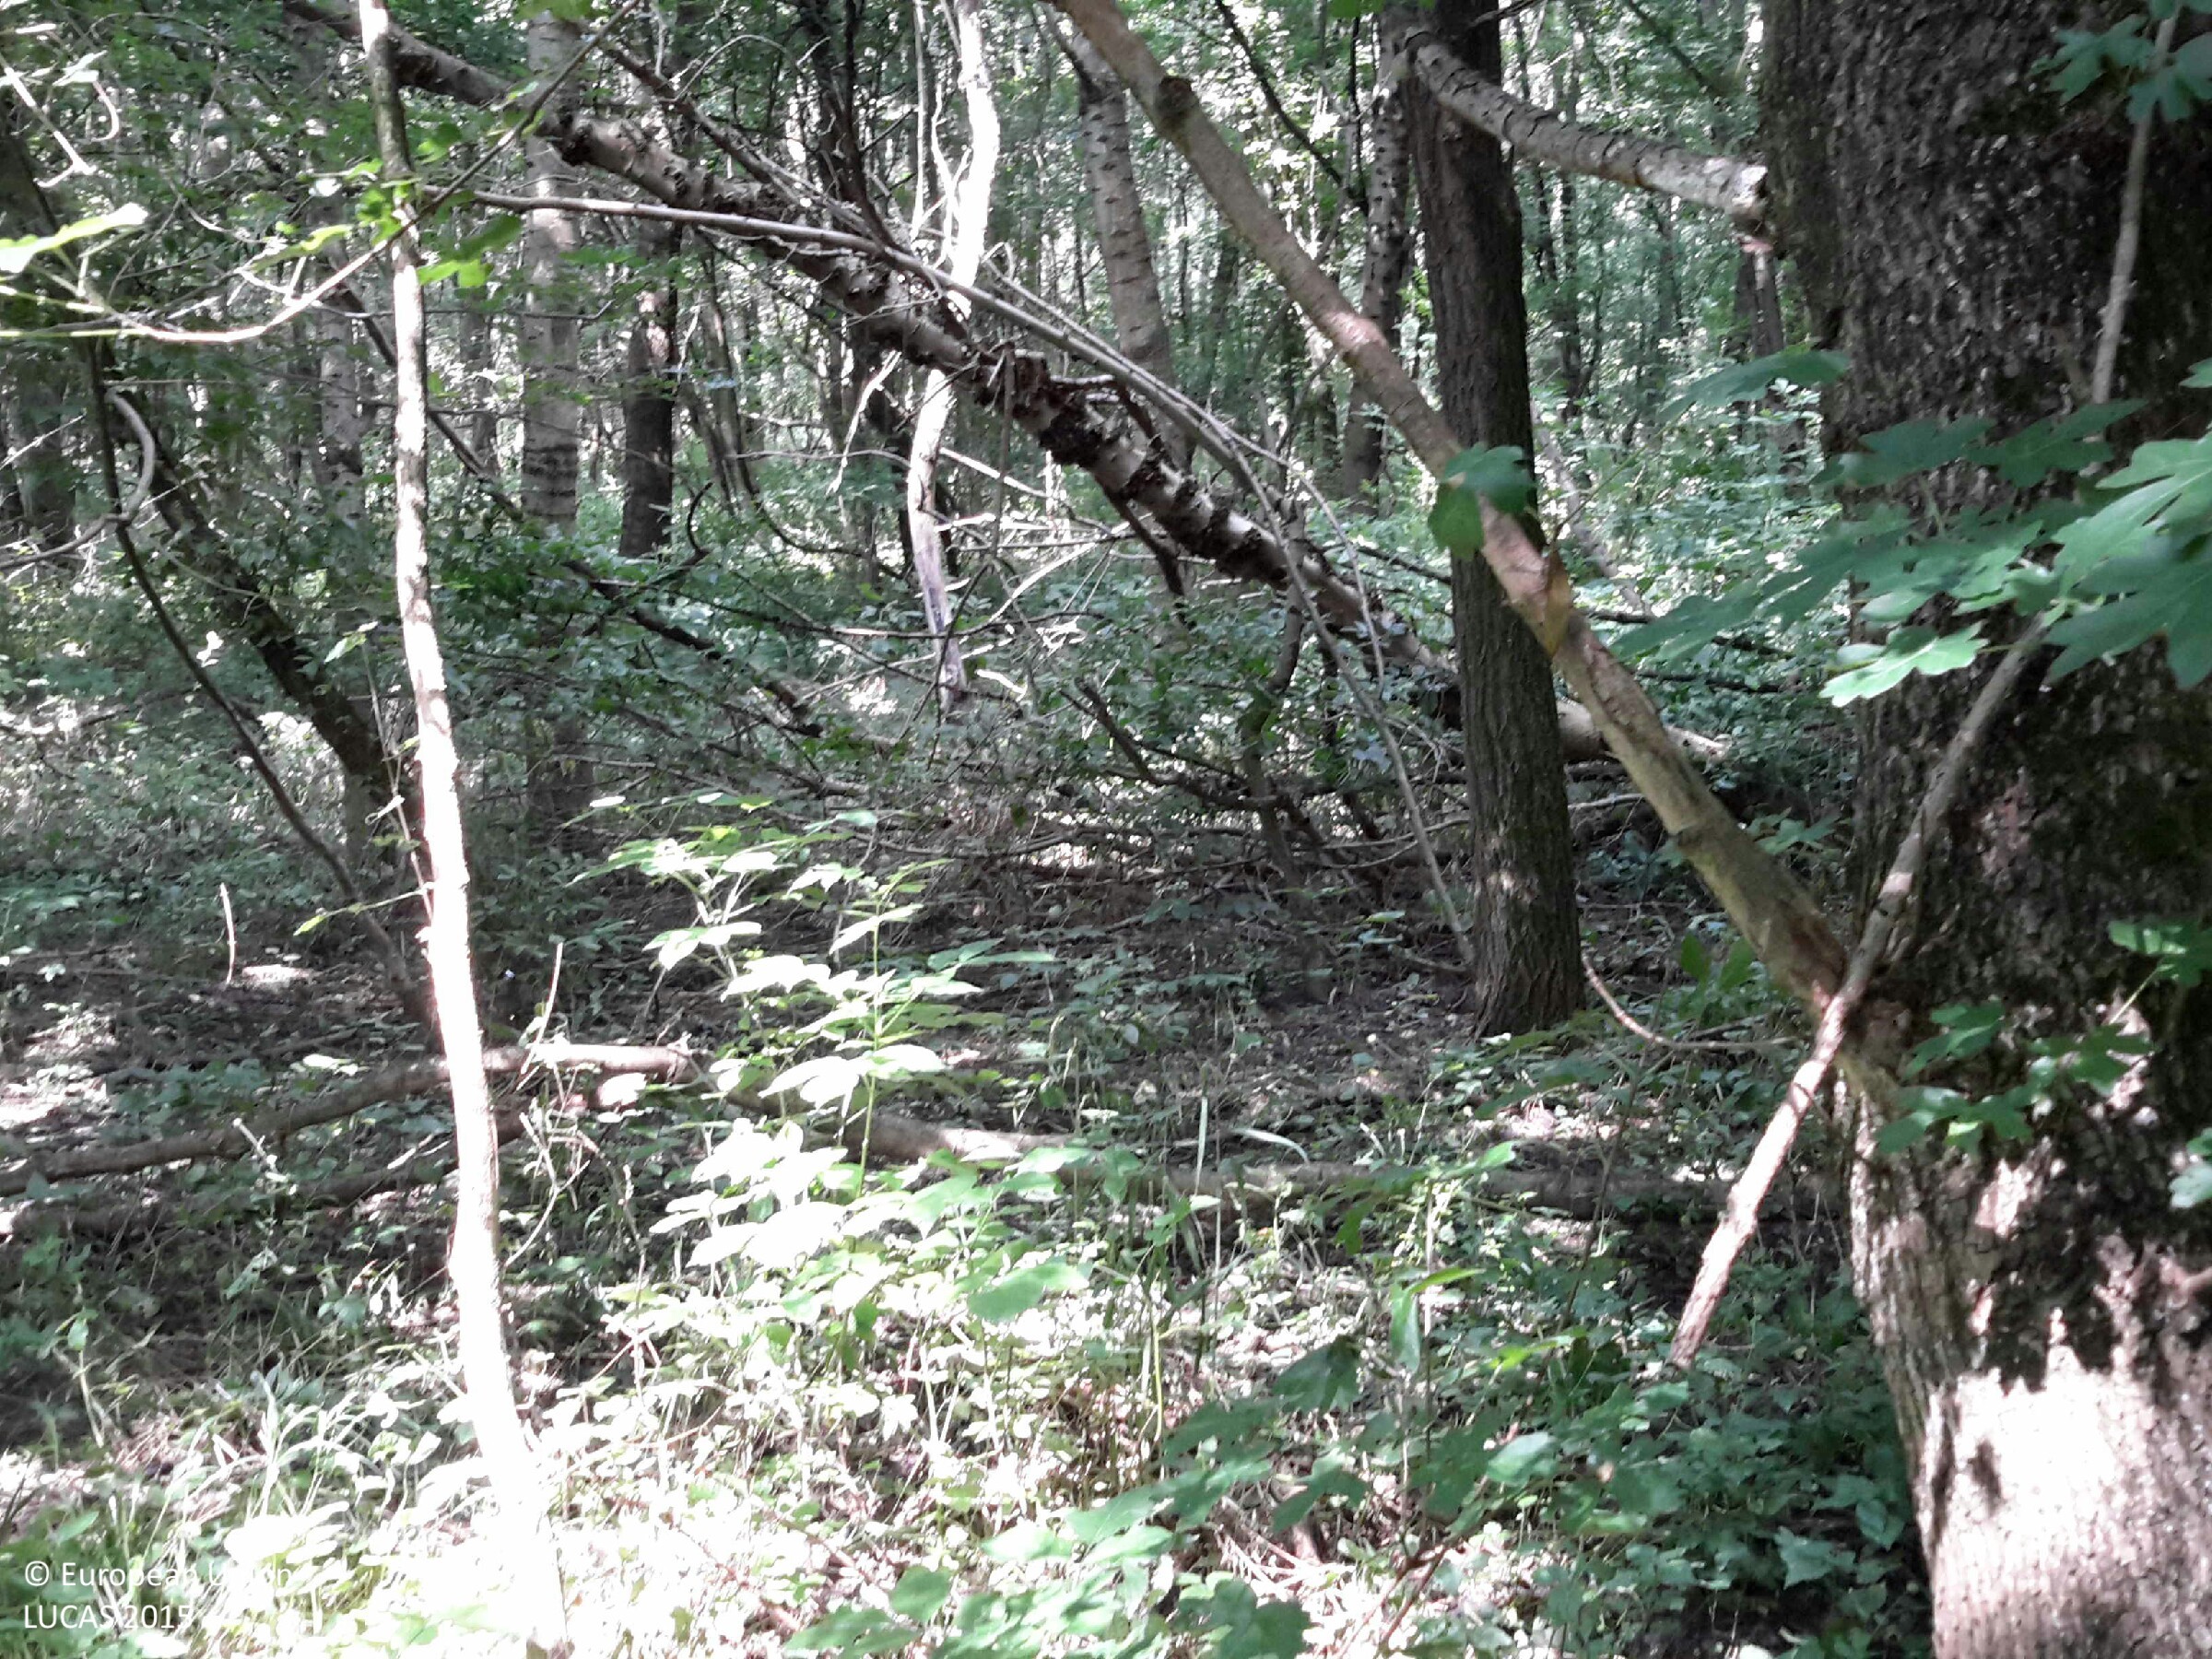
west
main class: Woodland
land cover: Broadleaved woodland
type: mesophytic deciduous forest
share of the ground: > 75 %
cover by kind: broadleaved forest trees 90 %, shrubs 5 %, herbaceous plants 5 %
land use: Forestry
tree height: > 5 m
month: July
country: HU
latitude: 47.4397
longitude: 17.0202
